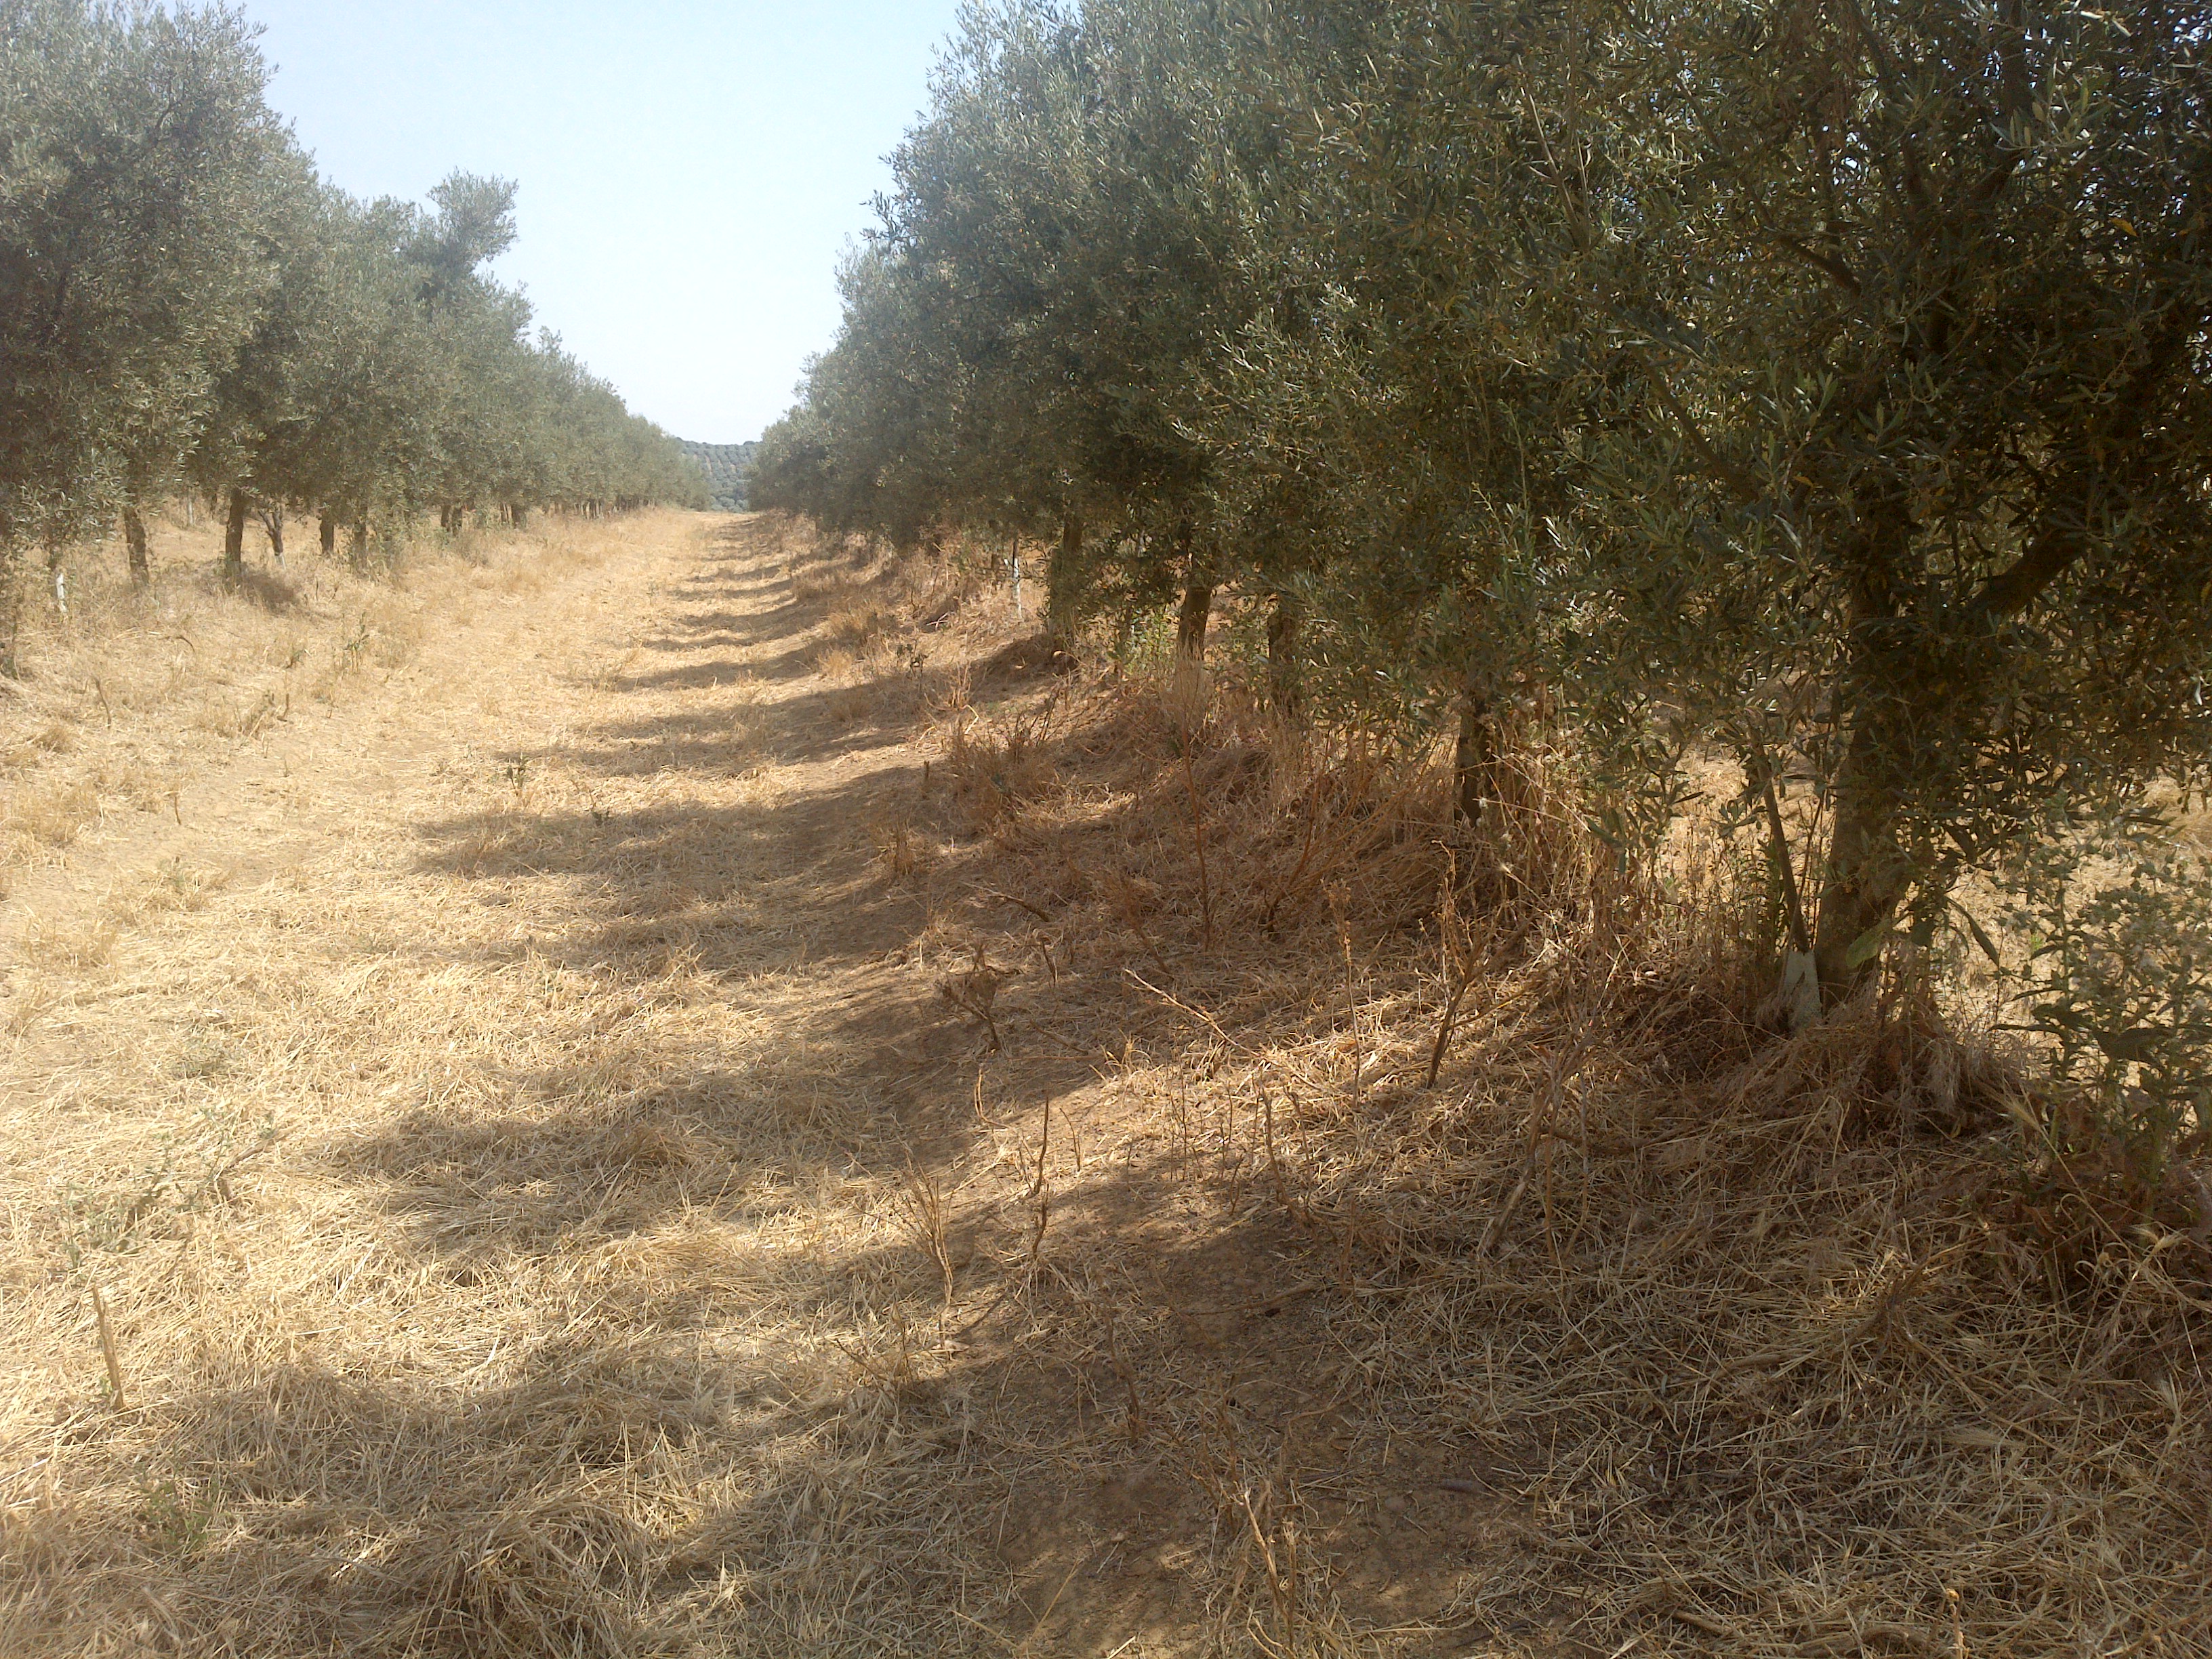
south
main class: Cropland
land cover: Olive groves
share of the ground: 25 - 50 %
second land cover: Spontaneously vegetated surfaces
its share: > 75 %
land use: Agriculture (excluding fallow land and kitchen gardens)
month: June
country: ES
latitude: 37.7845
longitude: -4.9926
